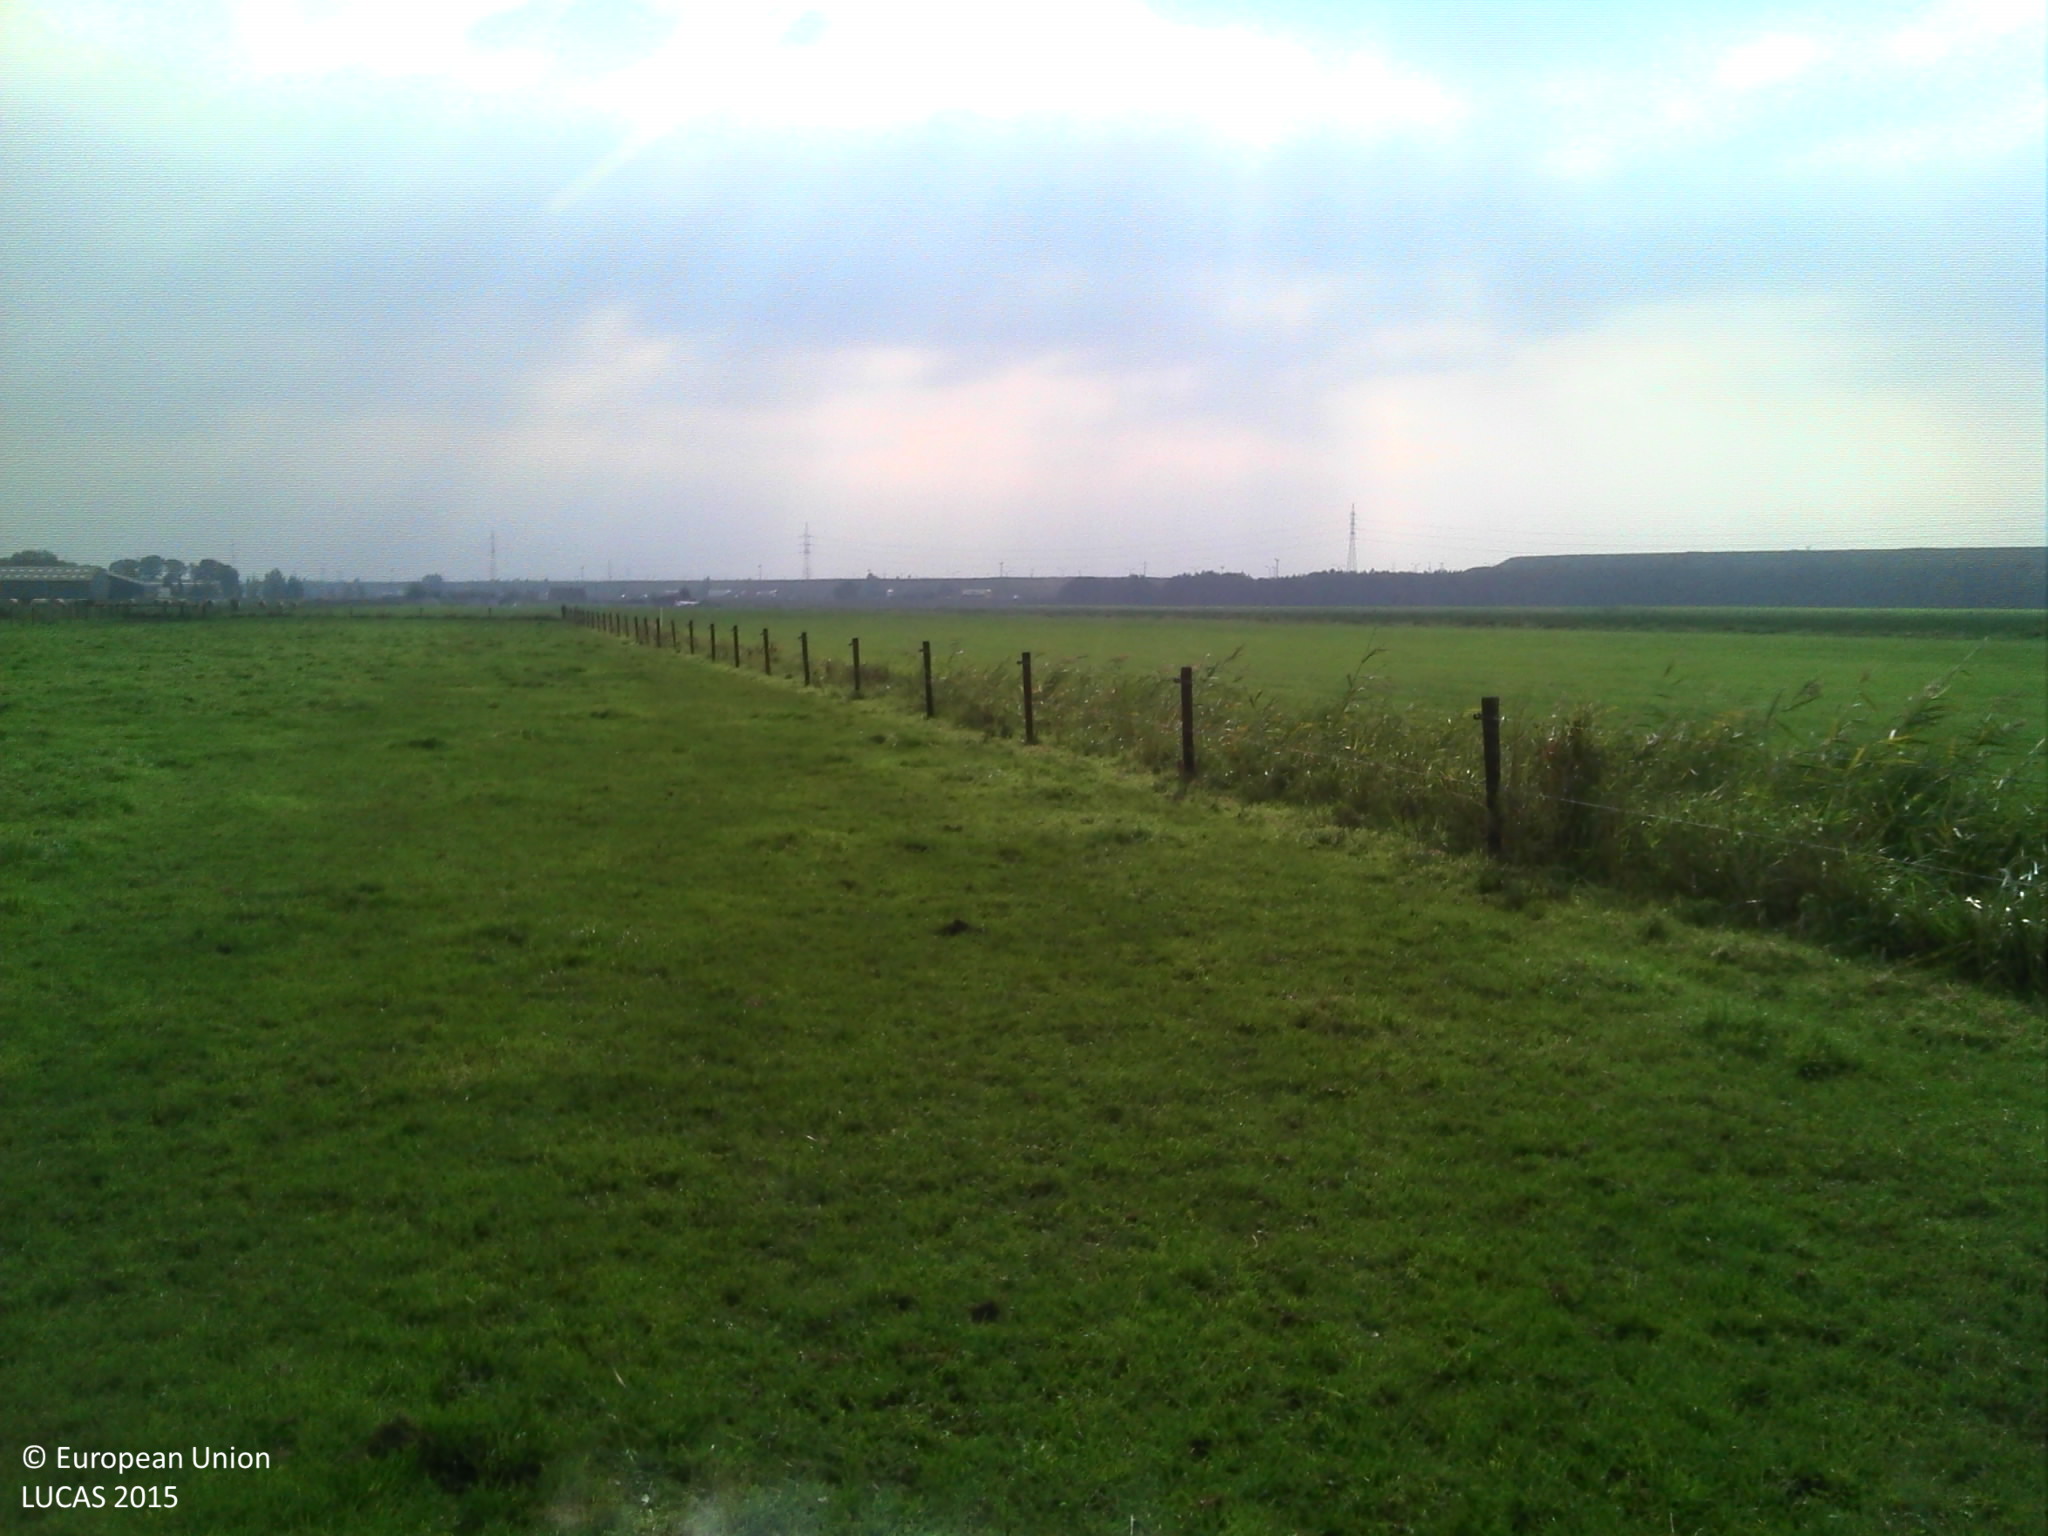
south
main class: Grassland
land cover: Grassland without tree/shrub cover
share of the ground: > 75 %
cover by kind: herbaceous plants 100 %
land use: Agriculture (excluding fallow land and kitchen gardens)
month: October
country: BE
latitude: 51.3077
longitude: 4.3865
